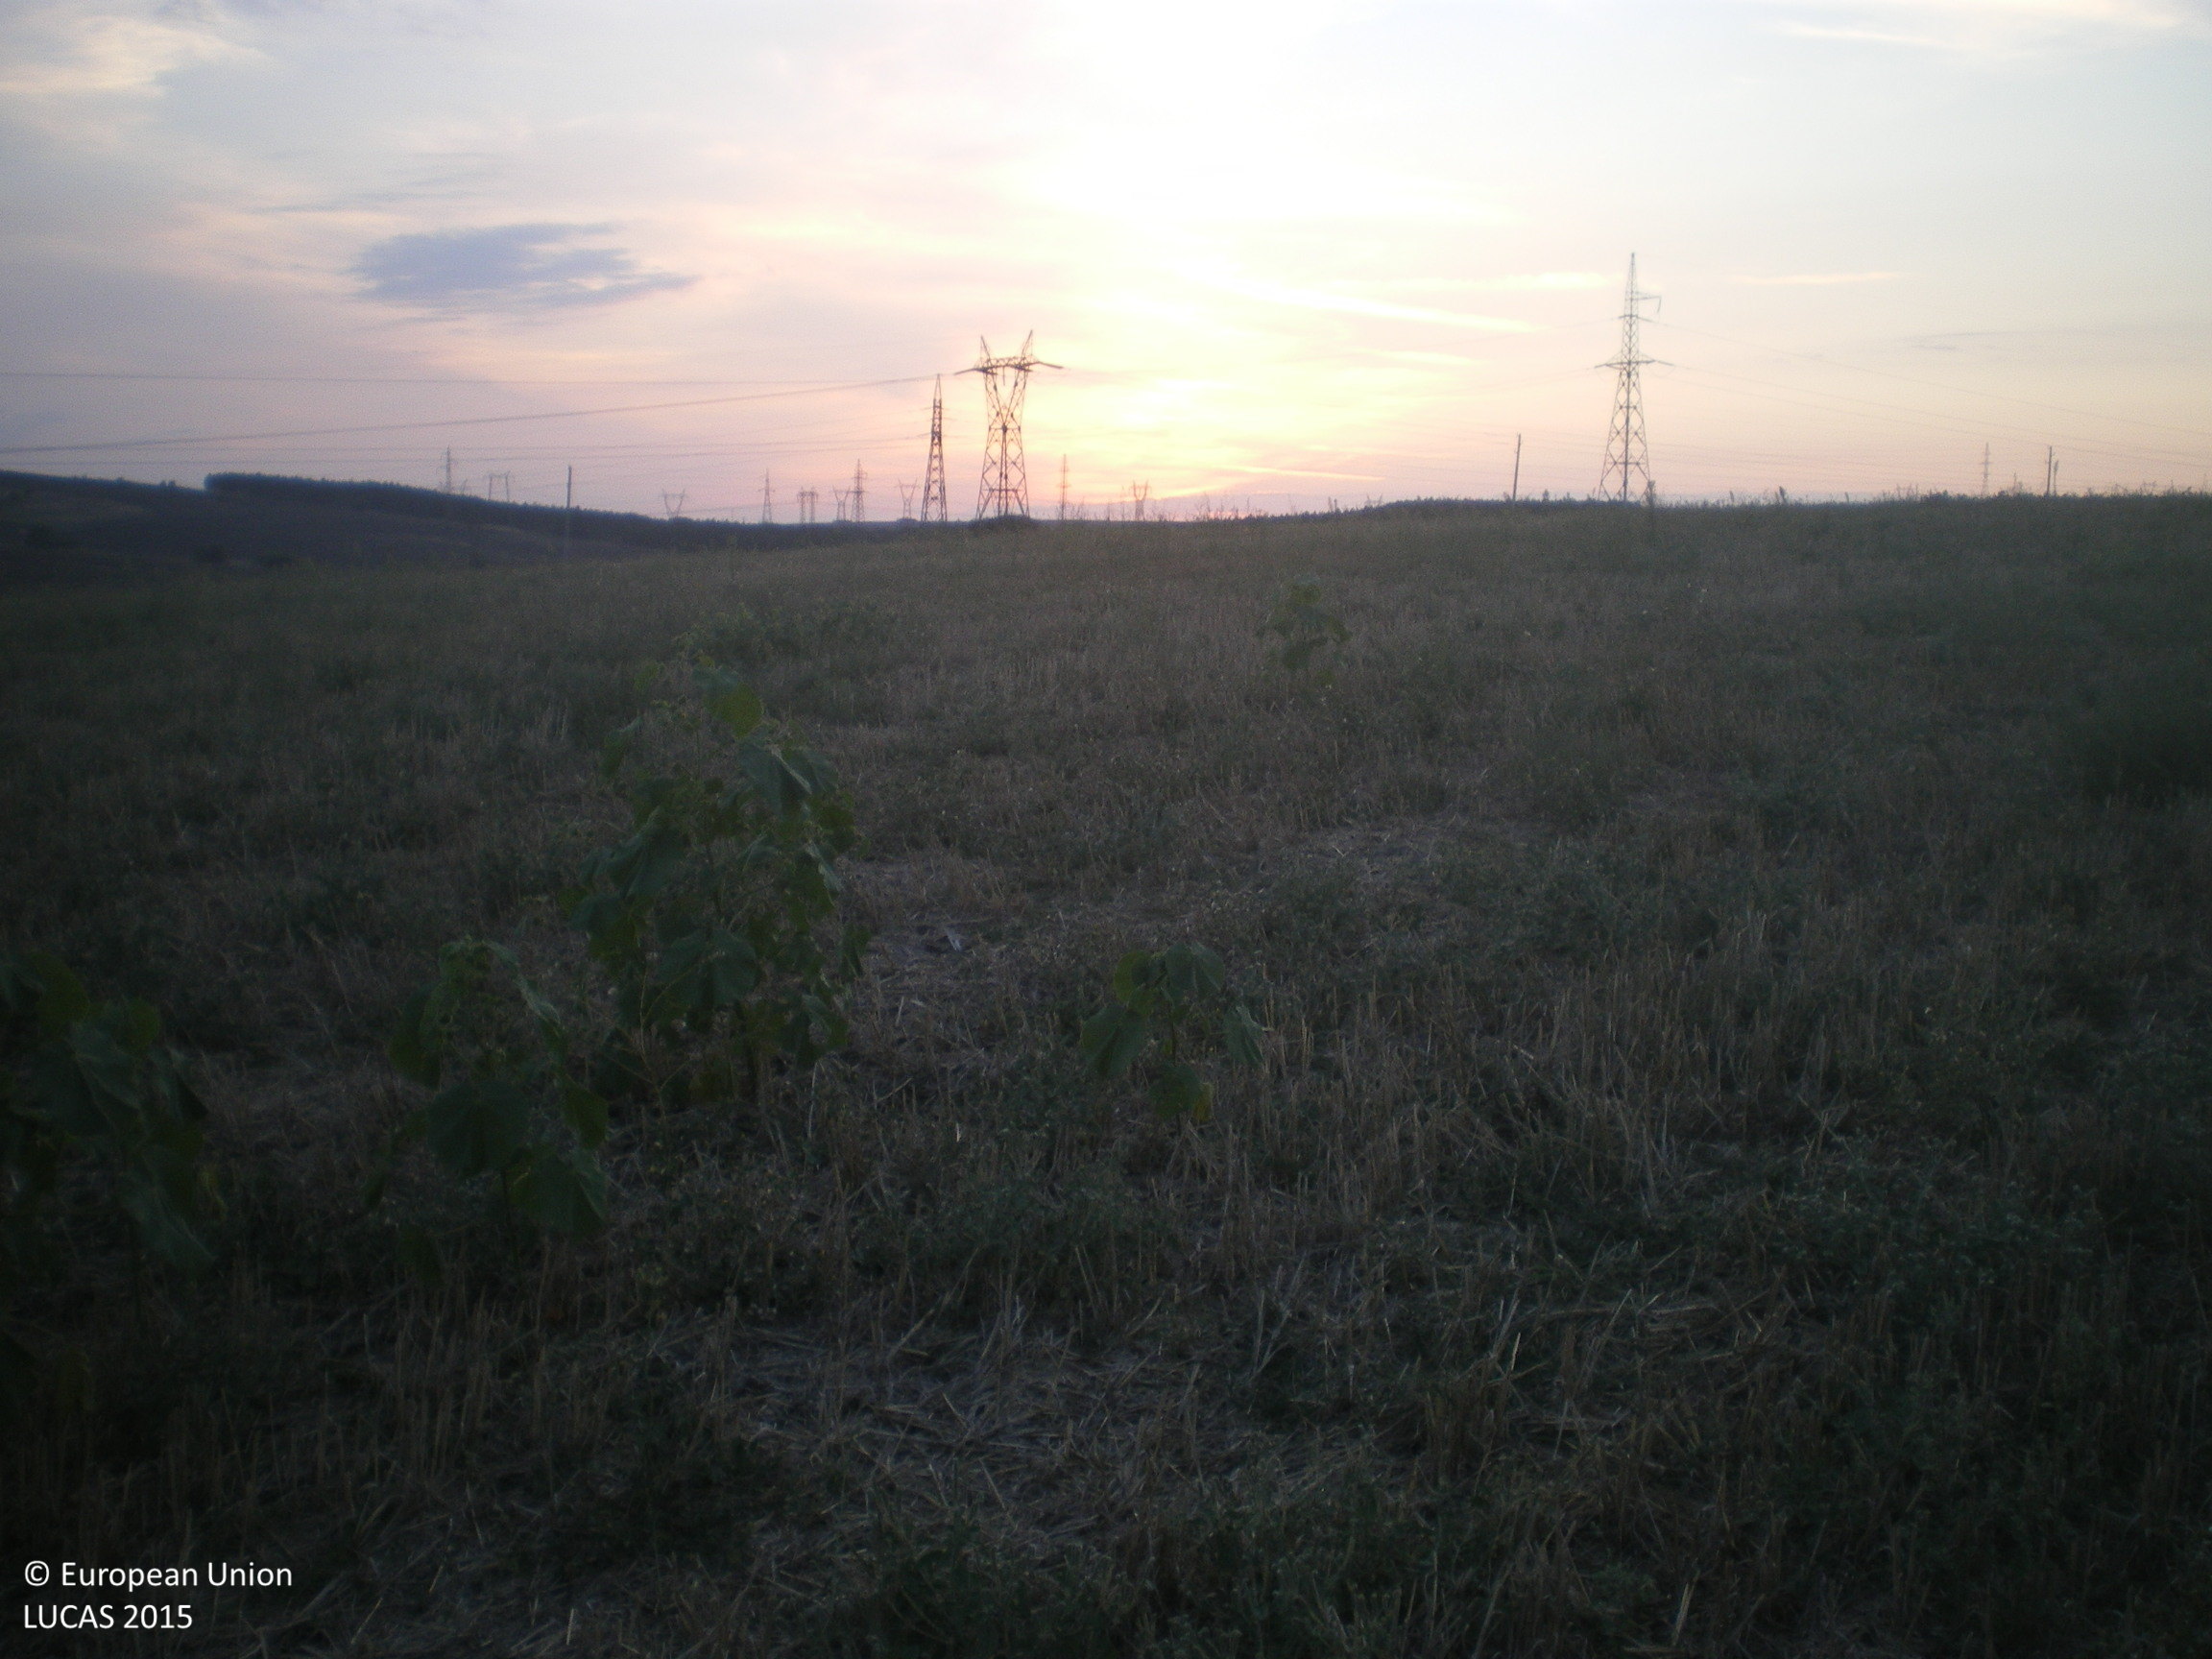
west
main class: Cropland
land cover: Common wheat
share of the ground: < 10 %
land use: Agriculture (excluding fallow land and kitchen gardens)
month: September
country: BG
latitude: 42.1299
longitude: 25.8603
